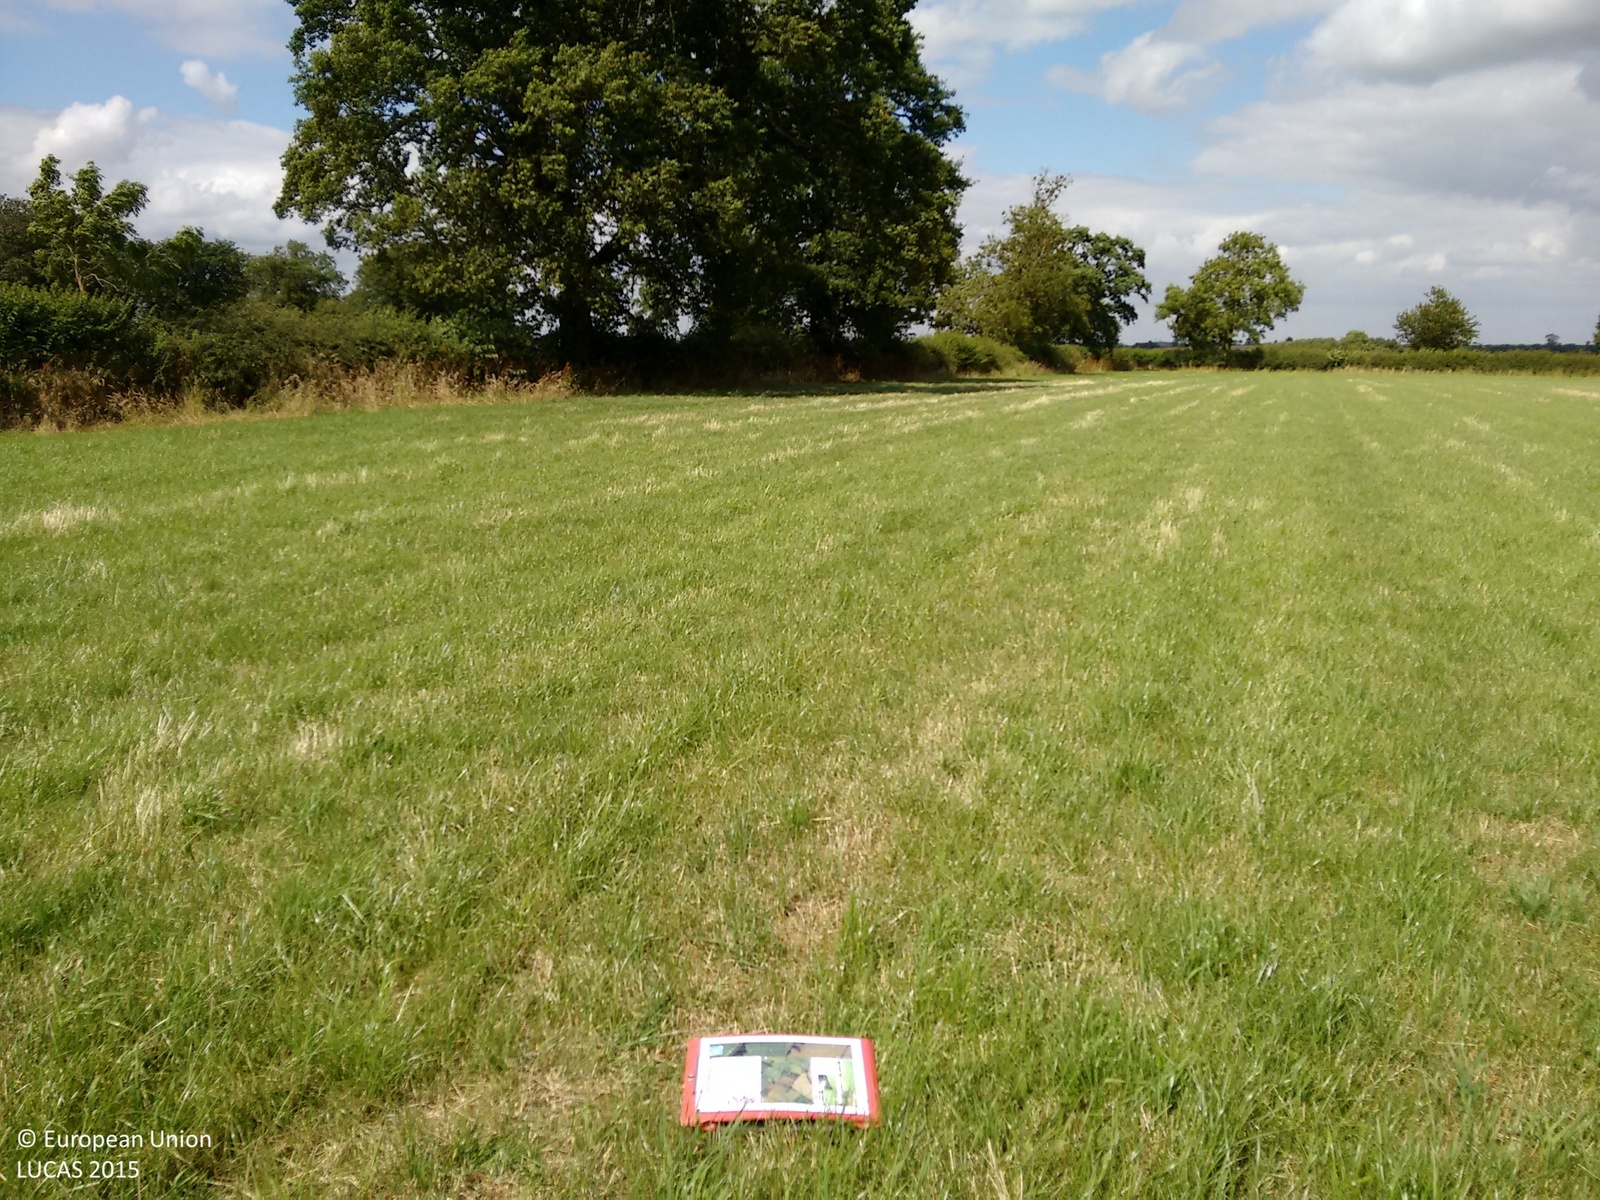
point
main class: Grassland
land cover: Grassland without tree/shrub cover
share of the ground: > 75 %
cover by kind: herbaceous plants 100 %
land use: Agriculture (excluding fallow land and kitchen gardens)
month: July
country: GB
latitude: 52.6658
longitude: -0.9710
